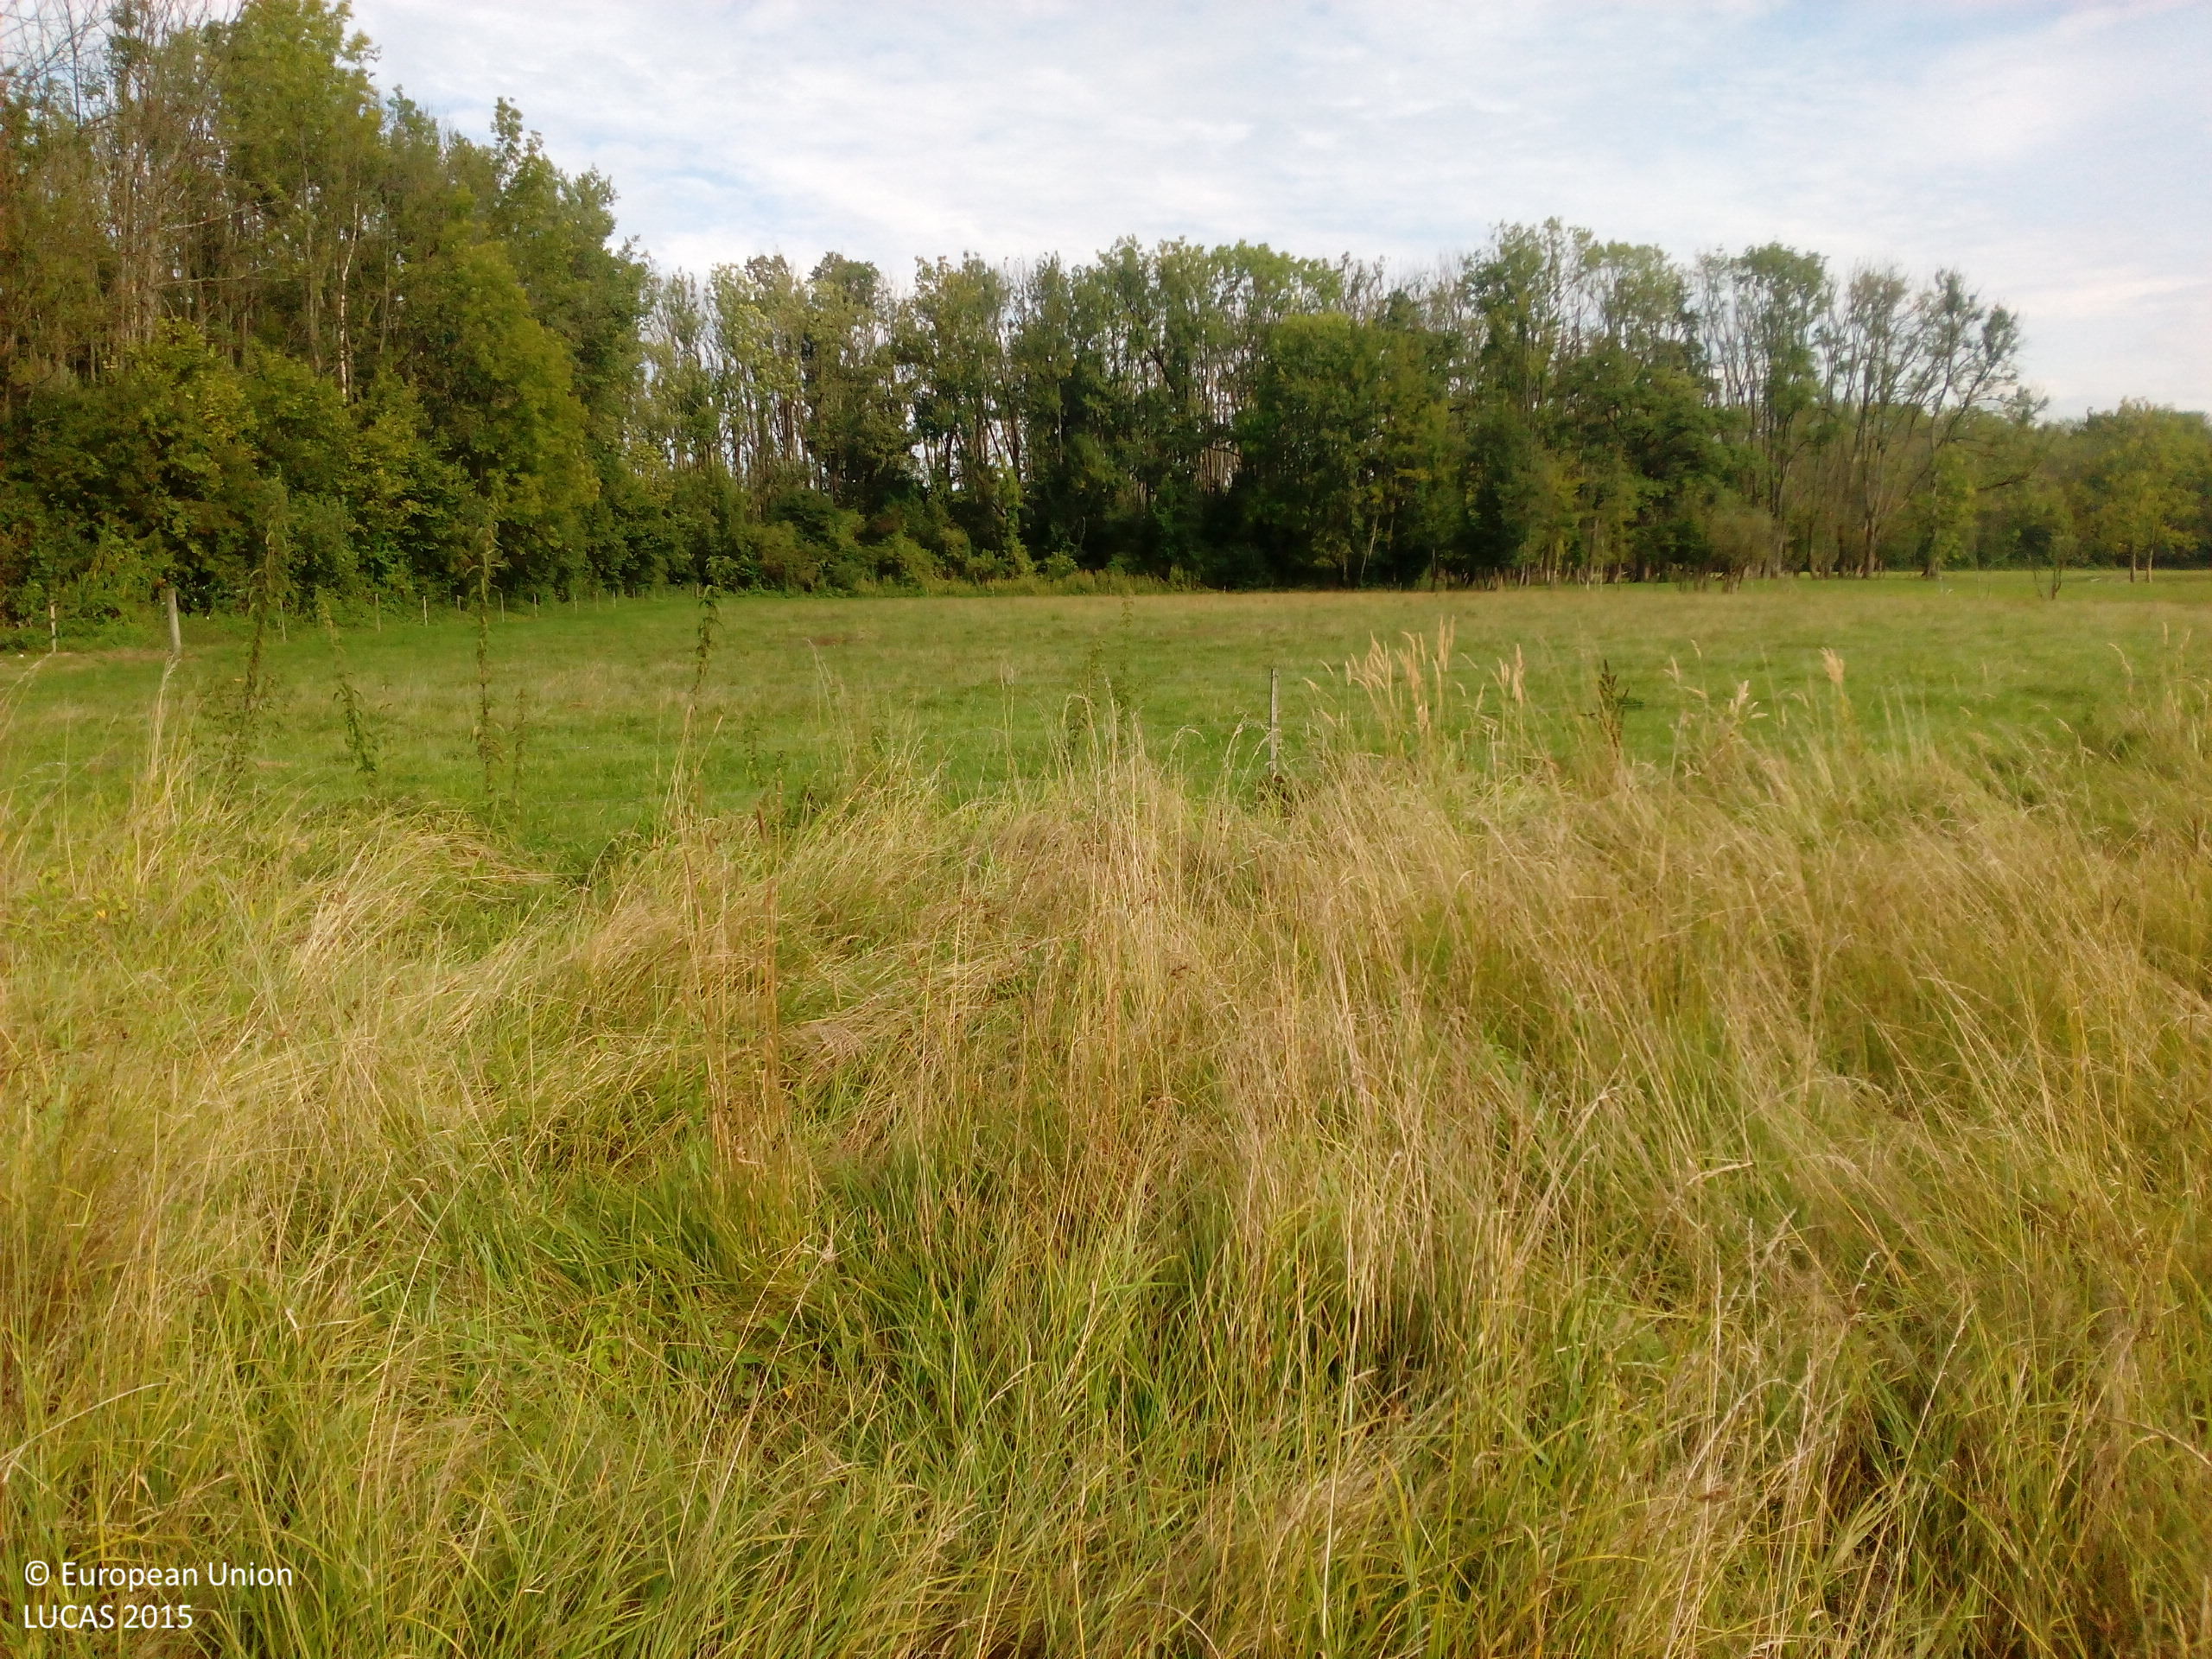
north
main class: Grassland
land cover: Grassland without tree/shrub cover
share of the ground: > 75 %
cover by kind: herbaceous plants 100 %
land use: Agriculture (excluding fallow land and kitchen gardens)
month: August
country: DE
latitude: 48.7782
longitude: 12.9525
